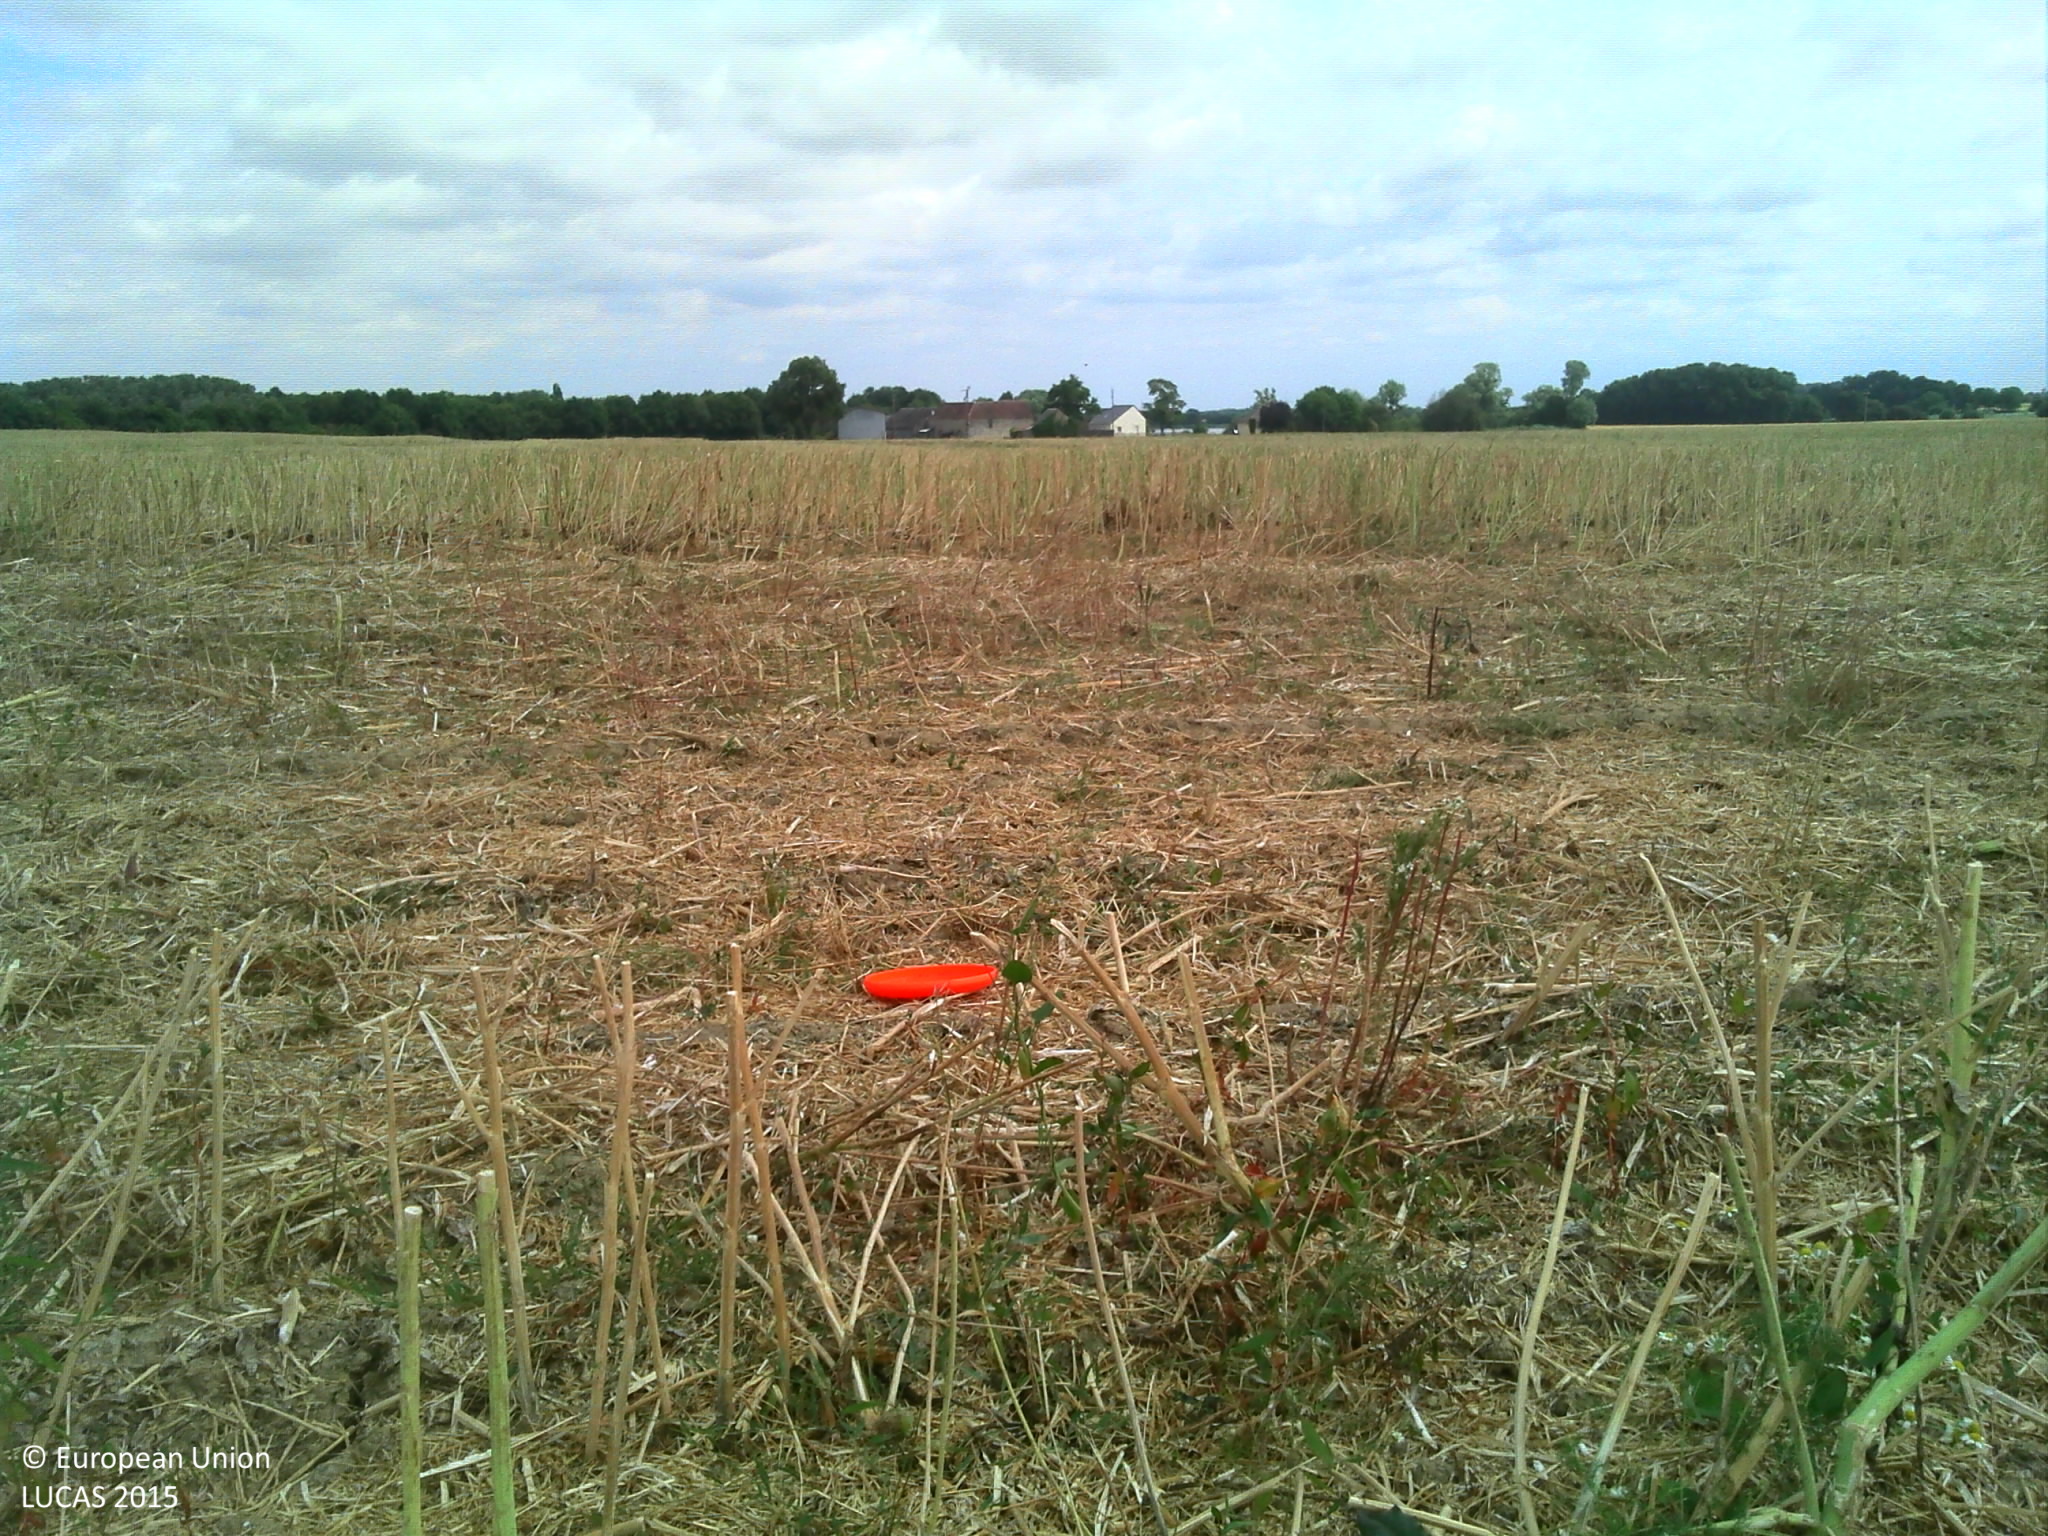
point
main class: Cropland
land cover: Rape and turnip rape
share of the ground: < 10 %
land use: Agriculture (excluding fallow land and kitchen gardens)
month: July
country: FR
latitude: 47.1468
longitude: 0.7642
